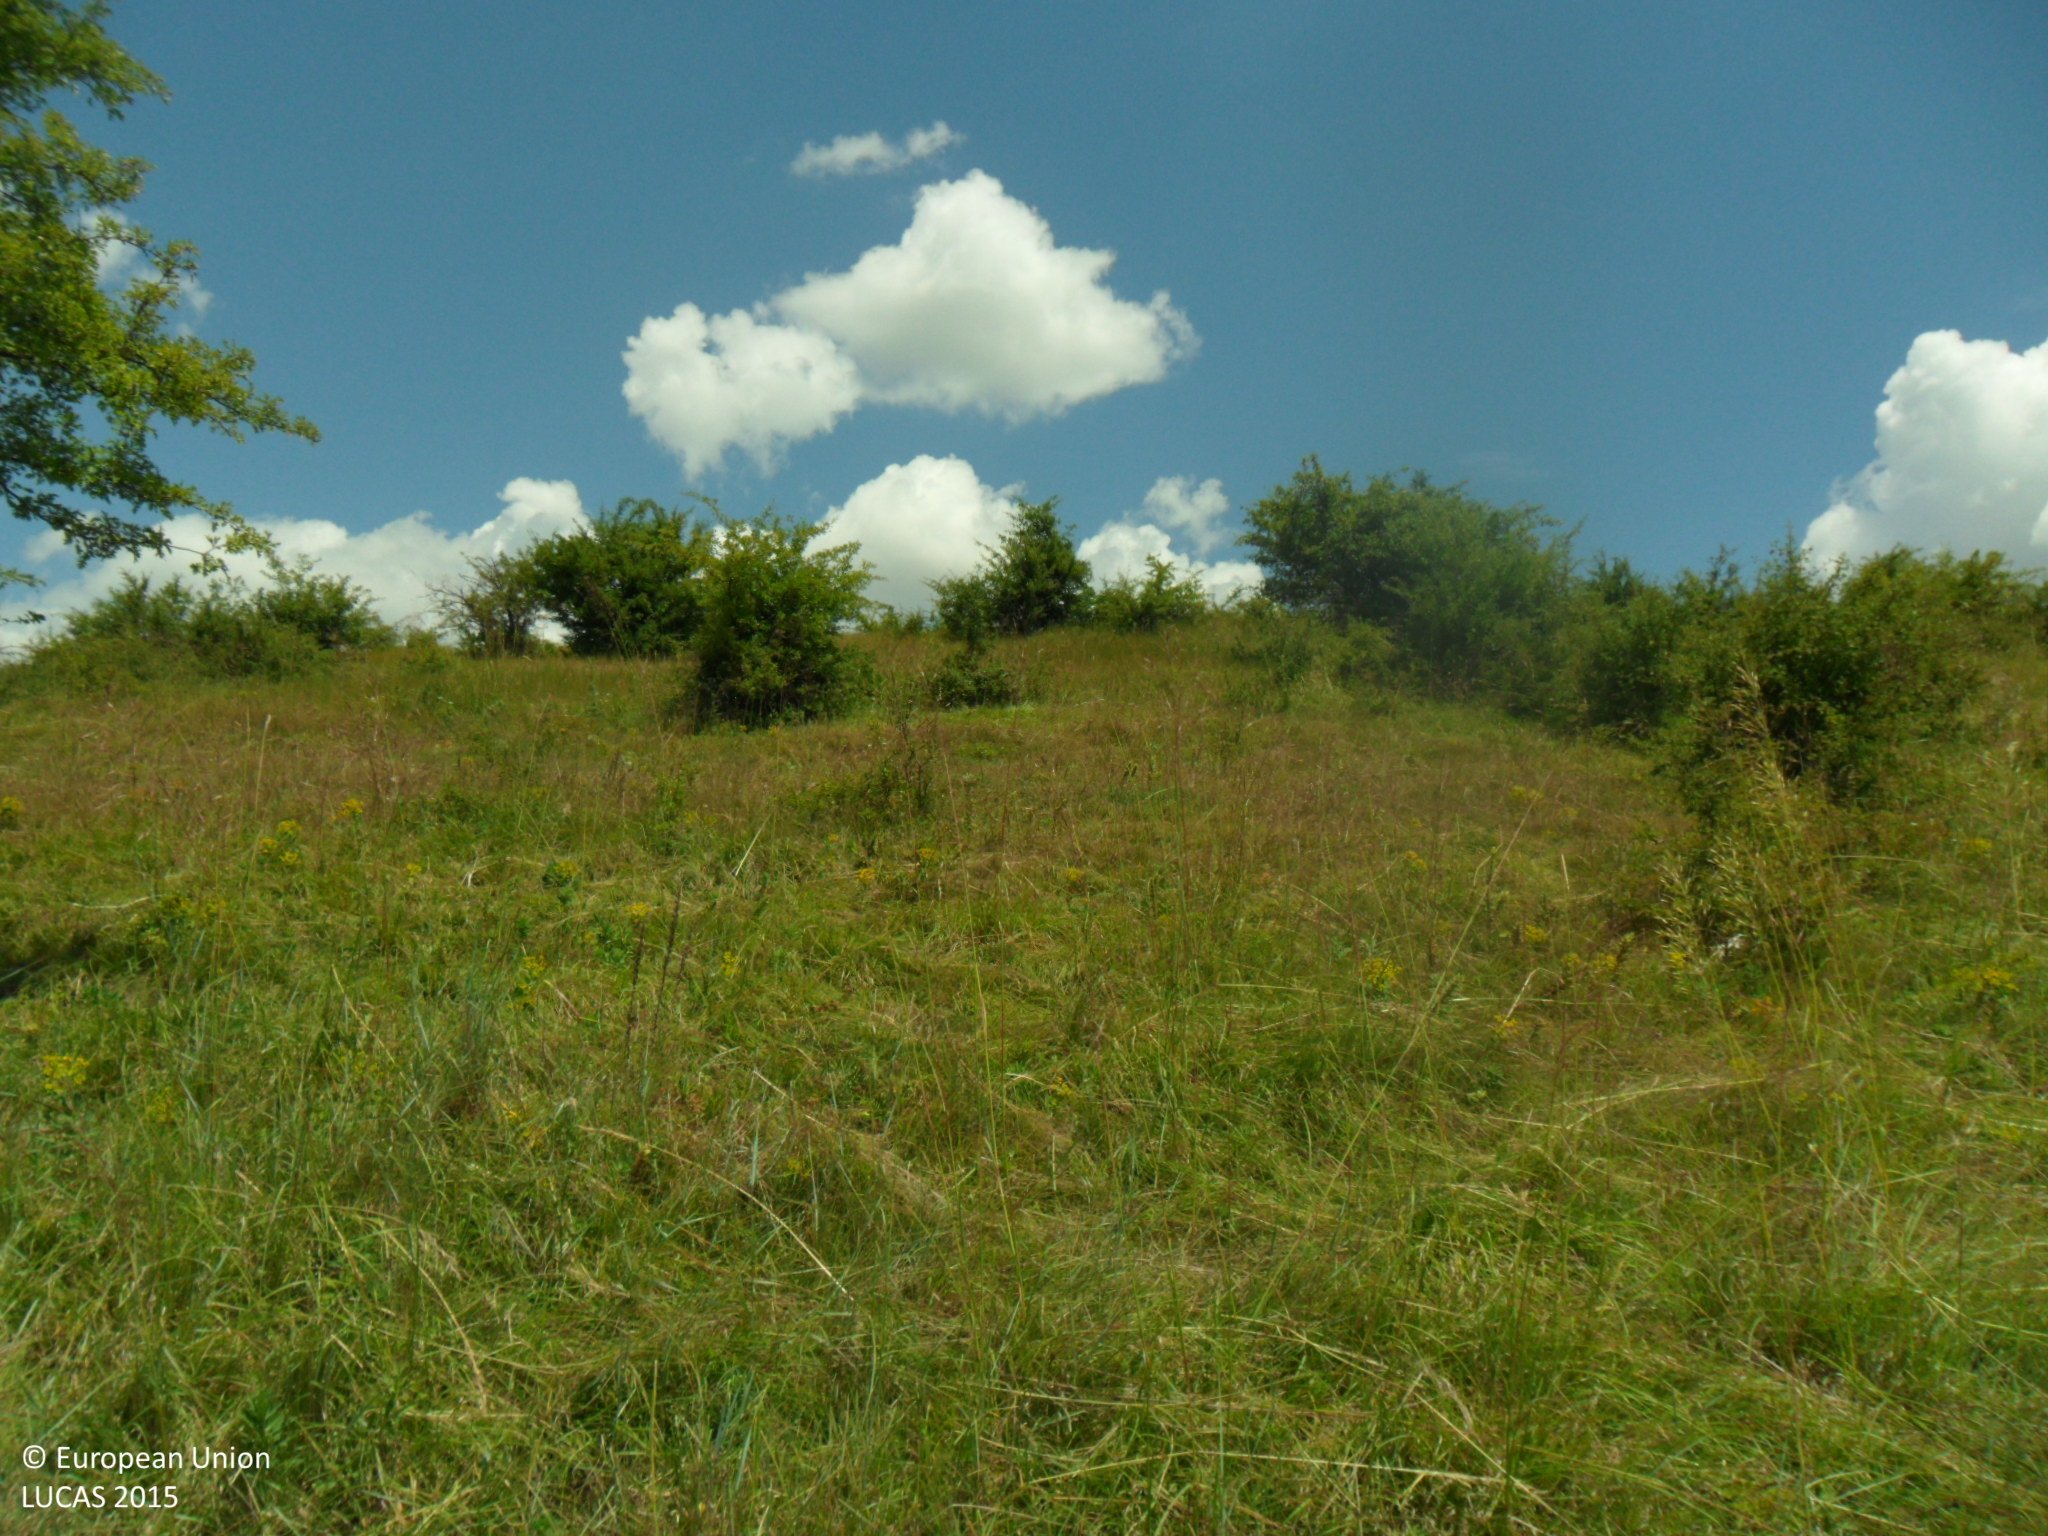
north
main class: Grassland
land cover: Grassland with sparse tree/shrub cover
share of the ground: > 75 %
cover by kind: herbaceous plants 85 %, shrubs 10 %, broadleaved forest trees 5 %
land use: Agriculture (excluding fallow land and kitchen gardens)
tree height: < 5 m
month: June
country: BG
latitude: 43.4152
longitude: 26.7709
